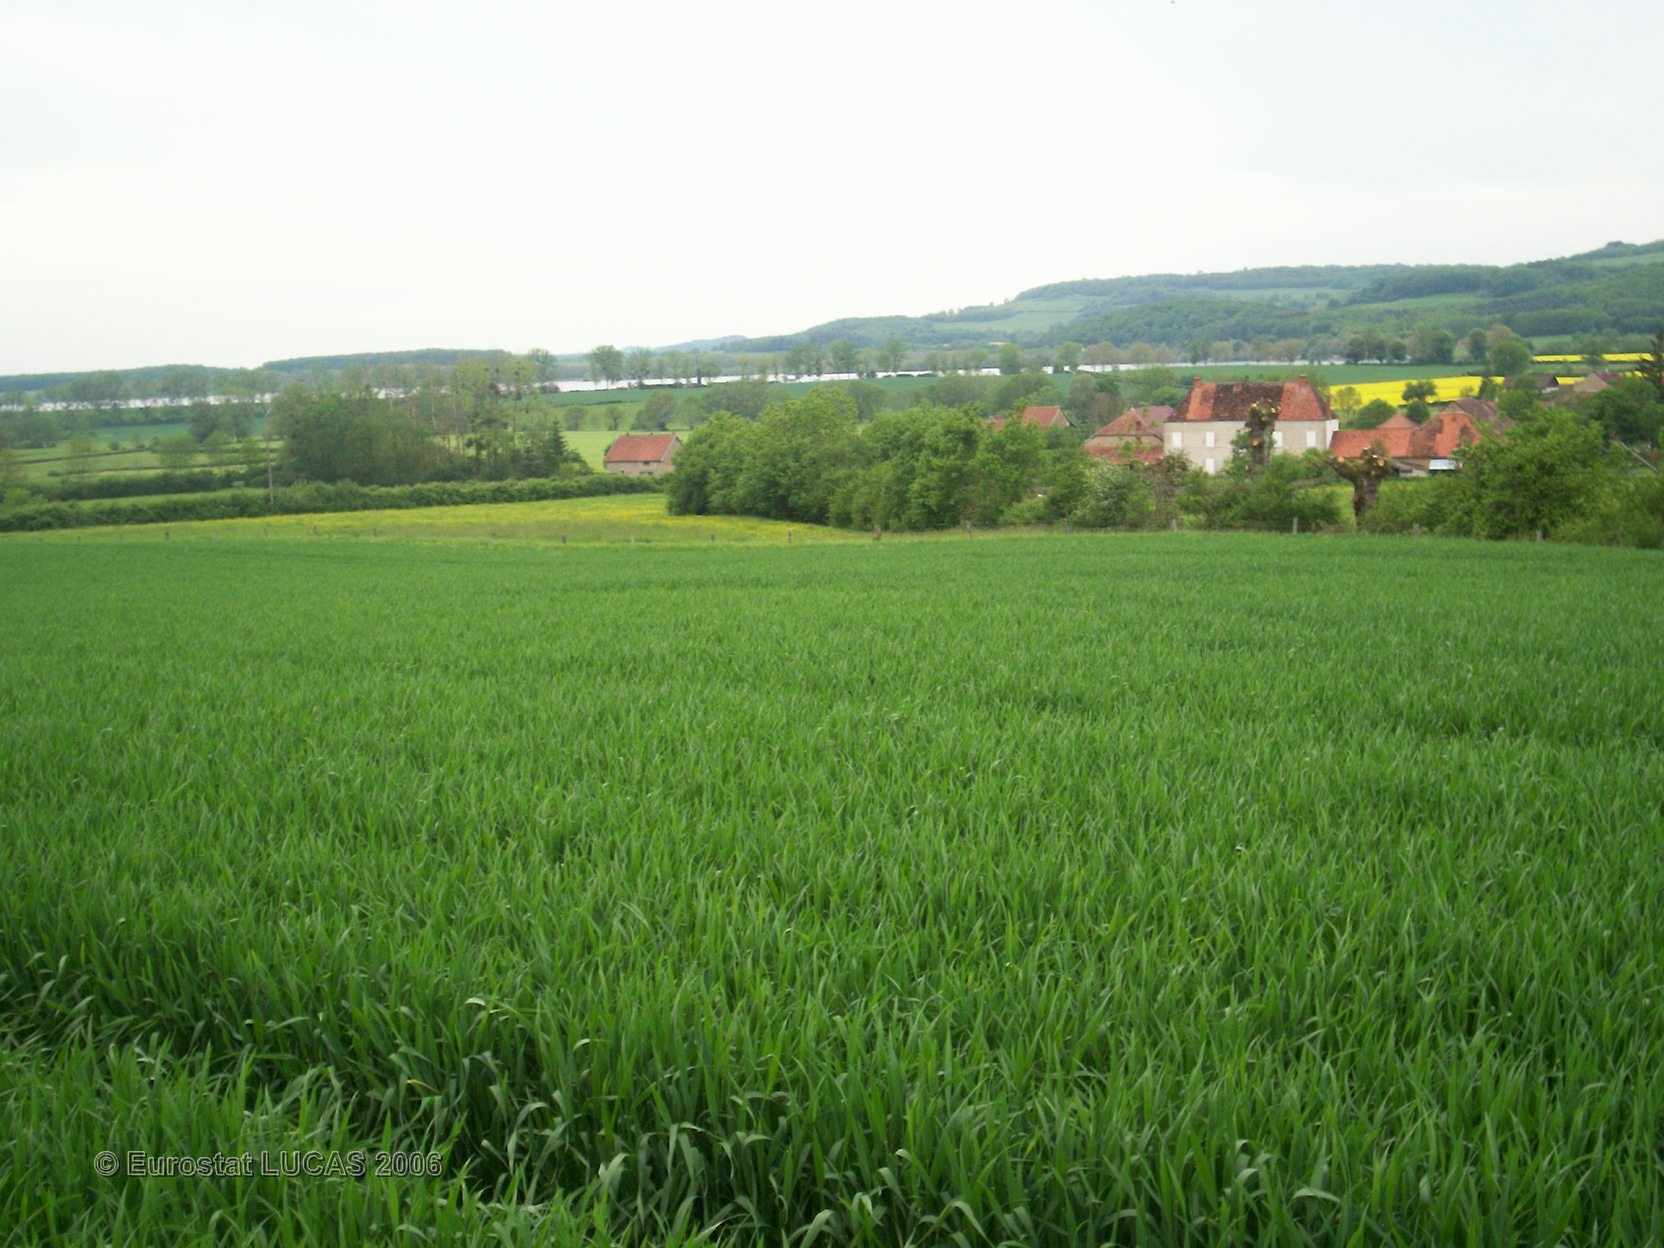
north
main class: Cropland
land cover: Common wheat
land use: Agriculture (excluding fallow land and kitchen gardens)
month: May
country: FR
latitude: 47.2459
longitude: 4.6492
